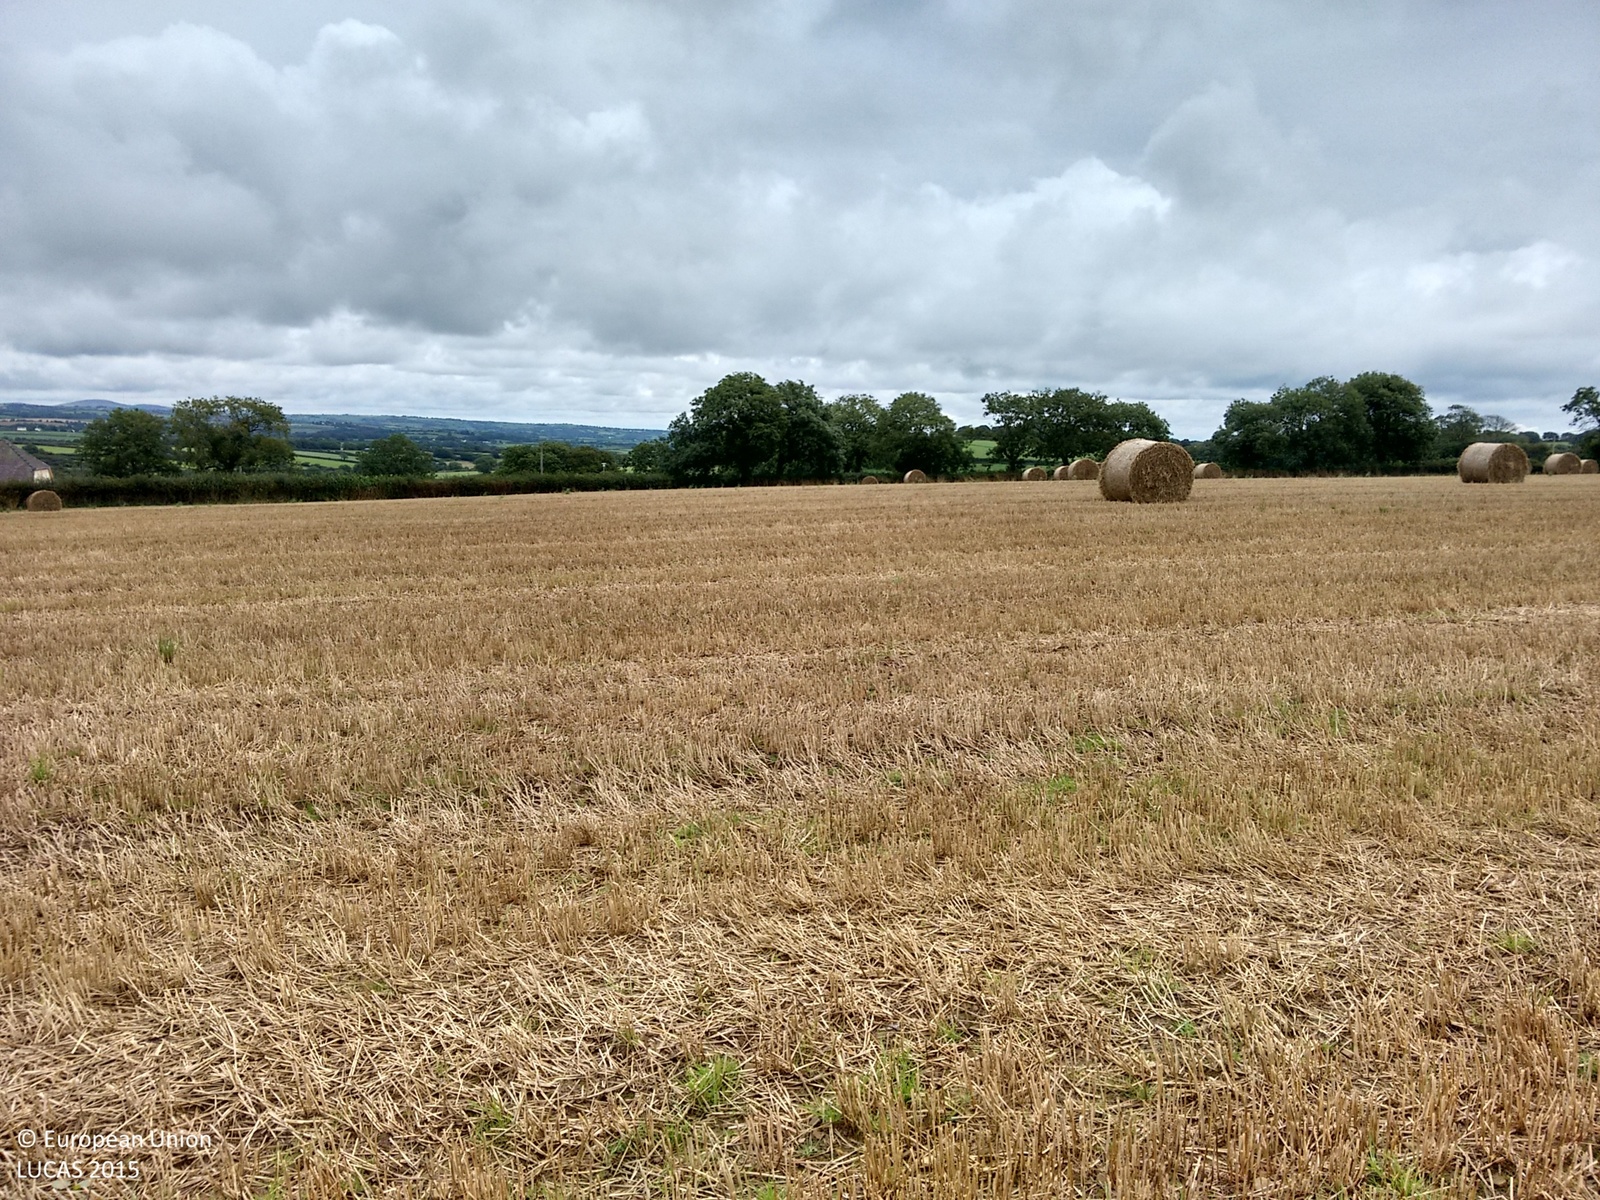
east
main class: Cropland
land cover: Barley
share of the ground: < 10 %
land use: Agriculture (excluding fallow land and kitchen gardens)
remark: Harvested field
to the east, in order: Barley; Managed hedges; Grass margins; Paved roads, cycling and walking lanes; Grass margins; Electric lines; Managed hedges; Fences; Tracks; Fences; Grassland without tree/shrub cover
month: August
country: GB
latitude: 51.8357
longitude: -4.8734
